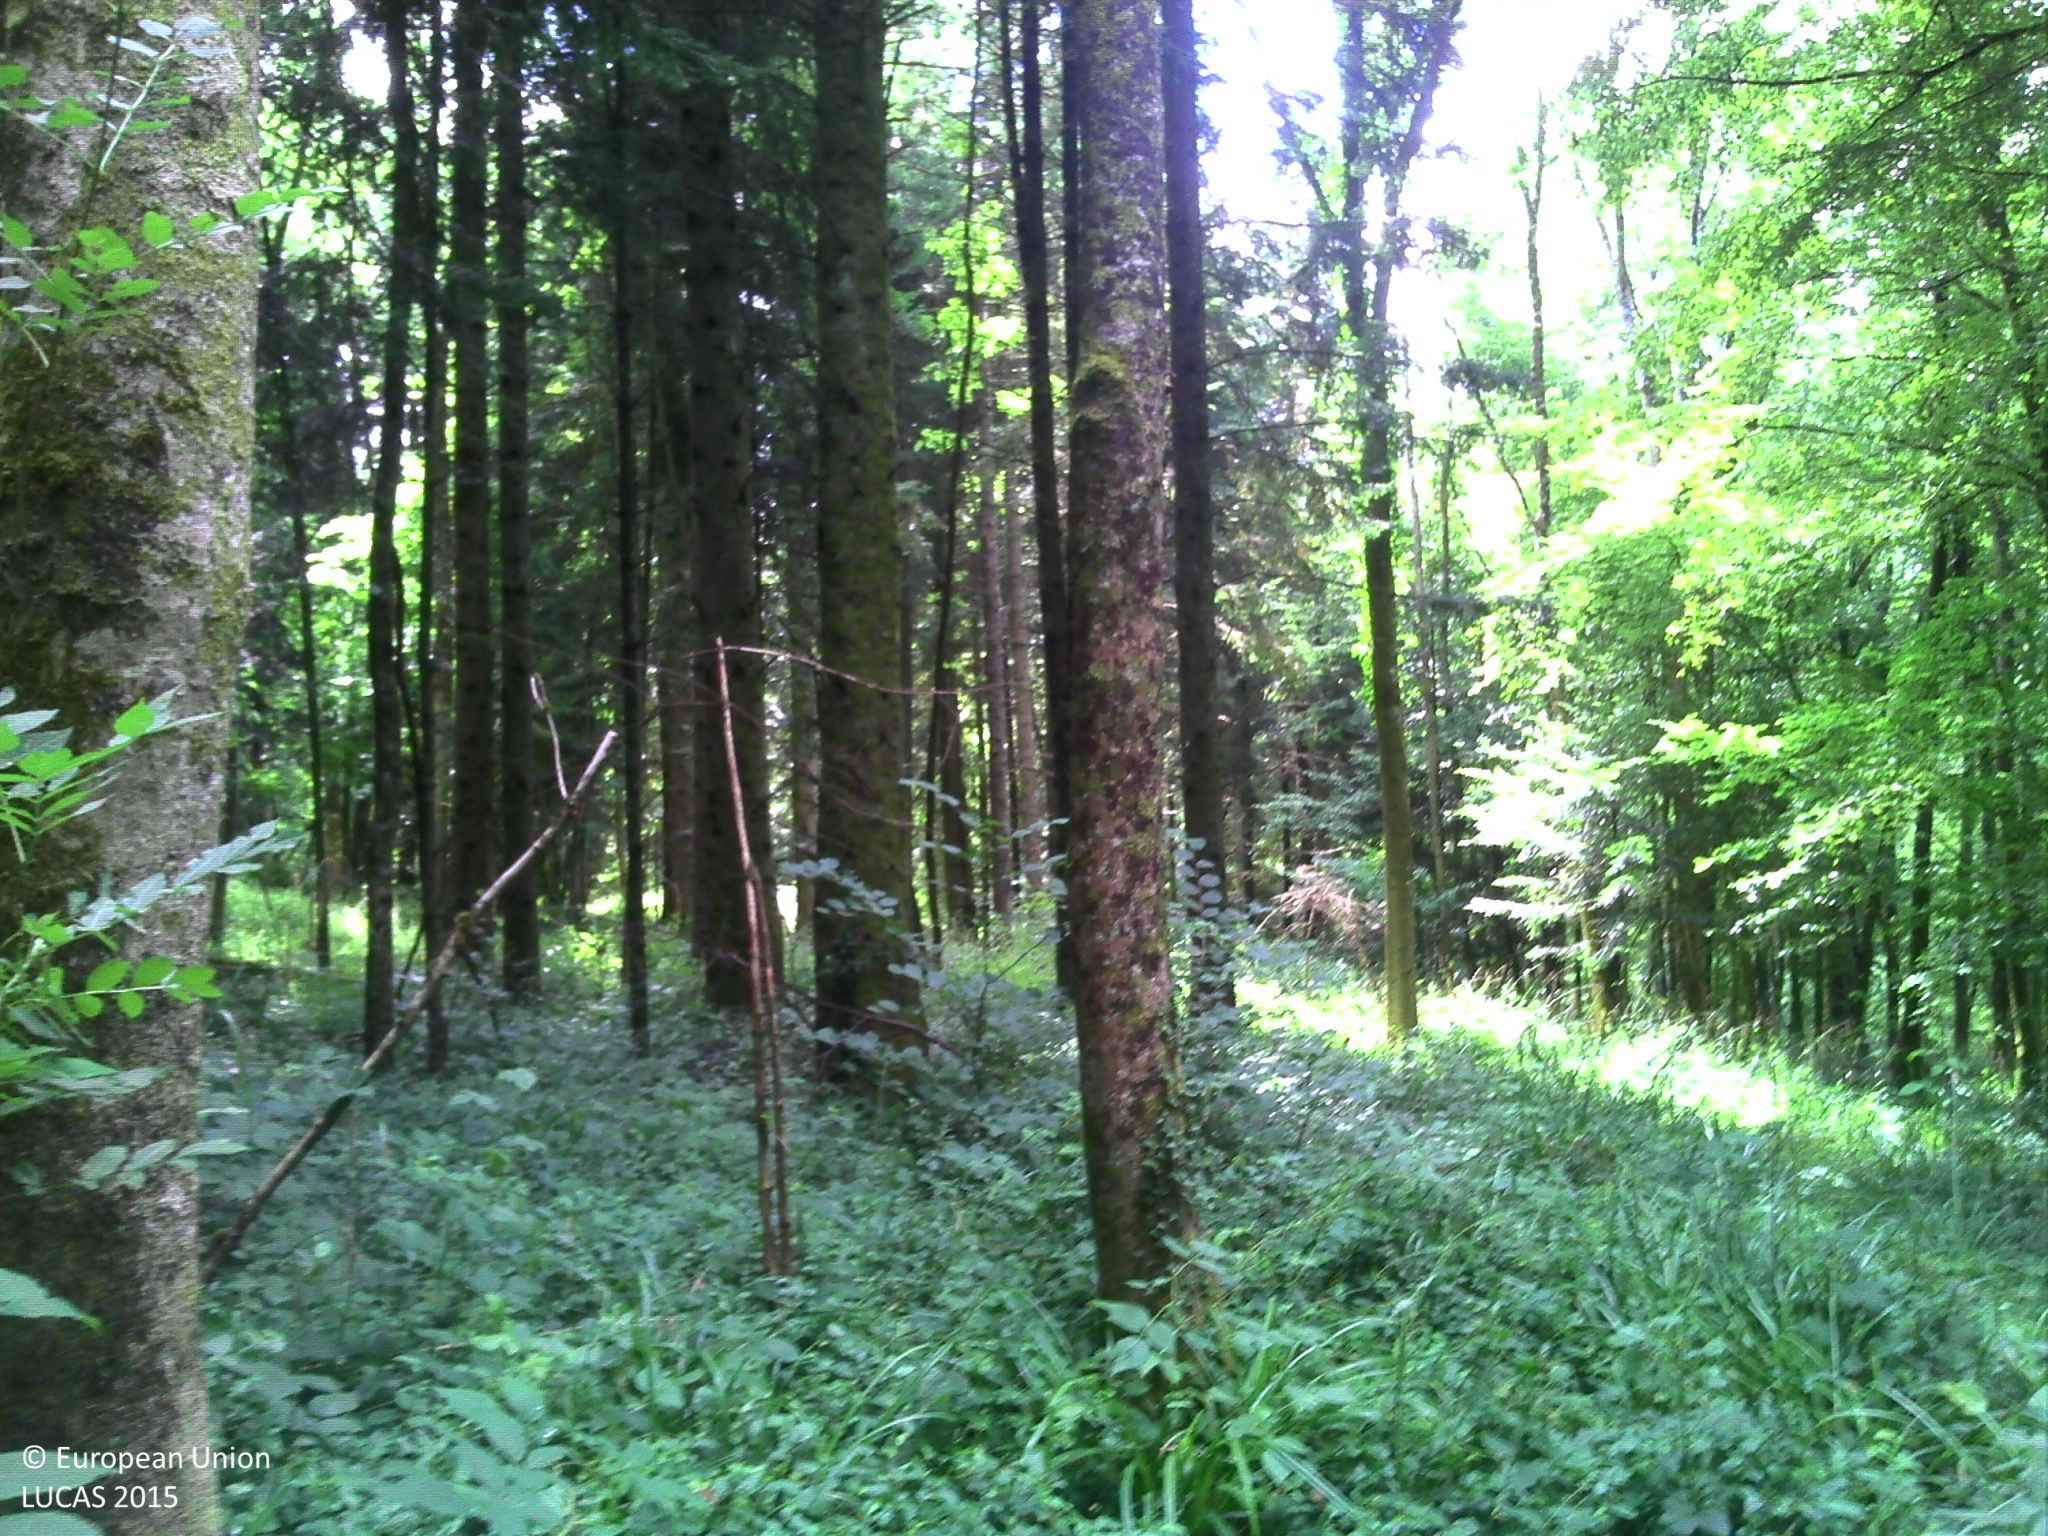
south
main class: Woodland
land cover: Broadleaved woodland
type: mesophytic deciduous forest
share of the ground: > 75 %
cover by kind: broadleaved forest trees 95 %, herbaceous plants 5 %
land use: Forestry
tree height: > 5 m
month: July
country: FR
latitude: 49.1781
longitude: 5.1007
